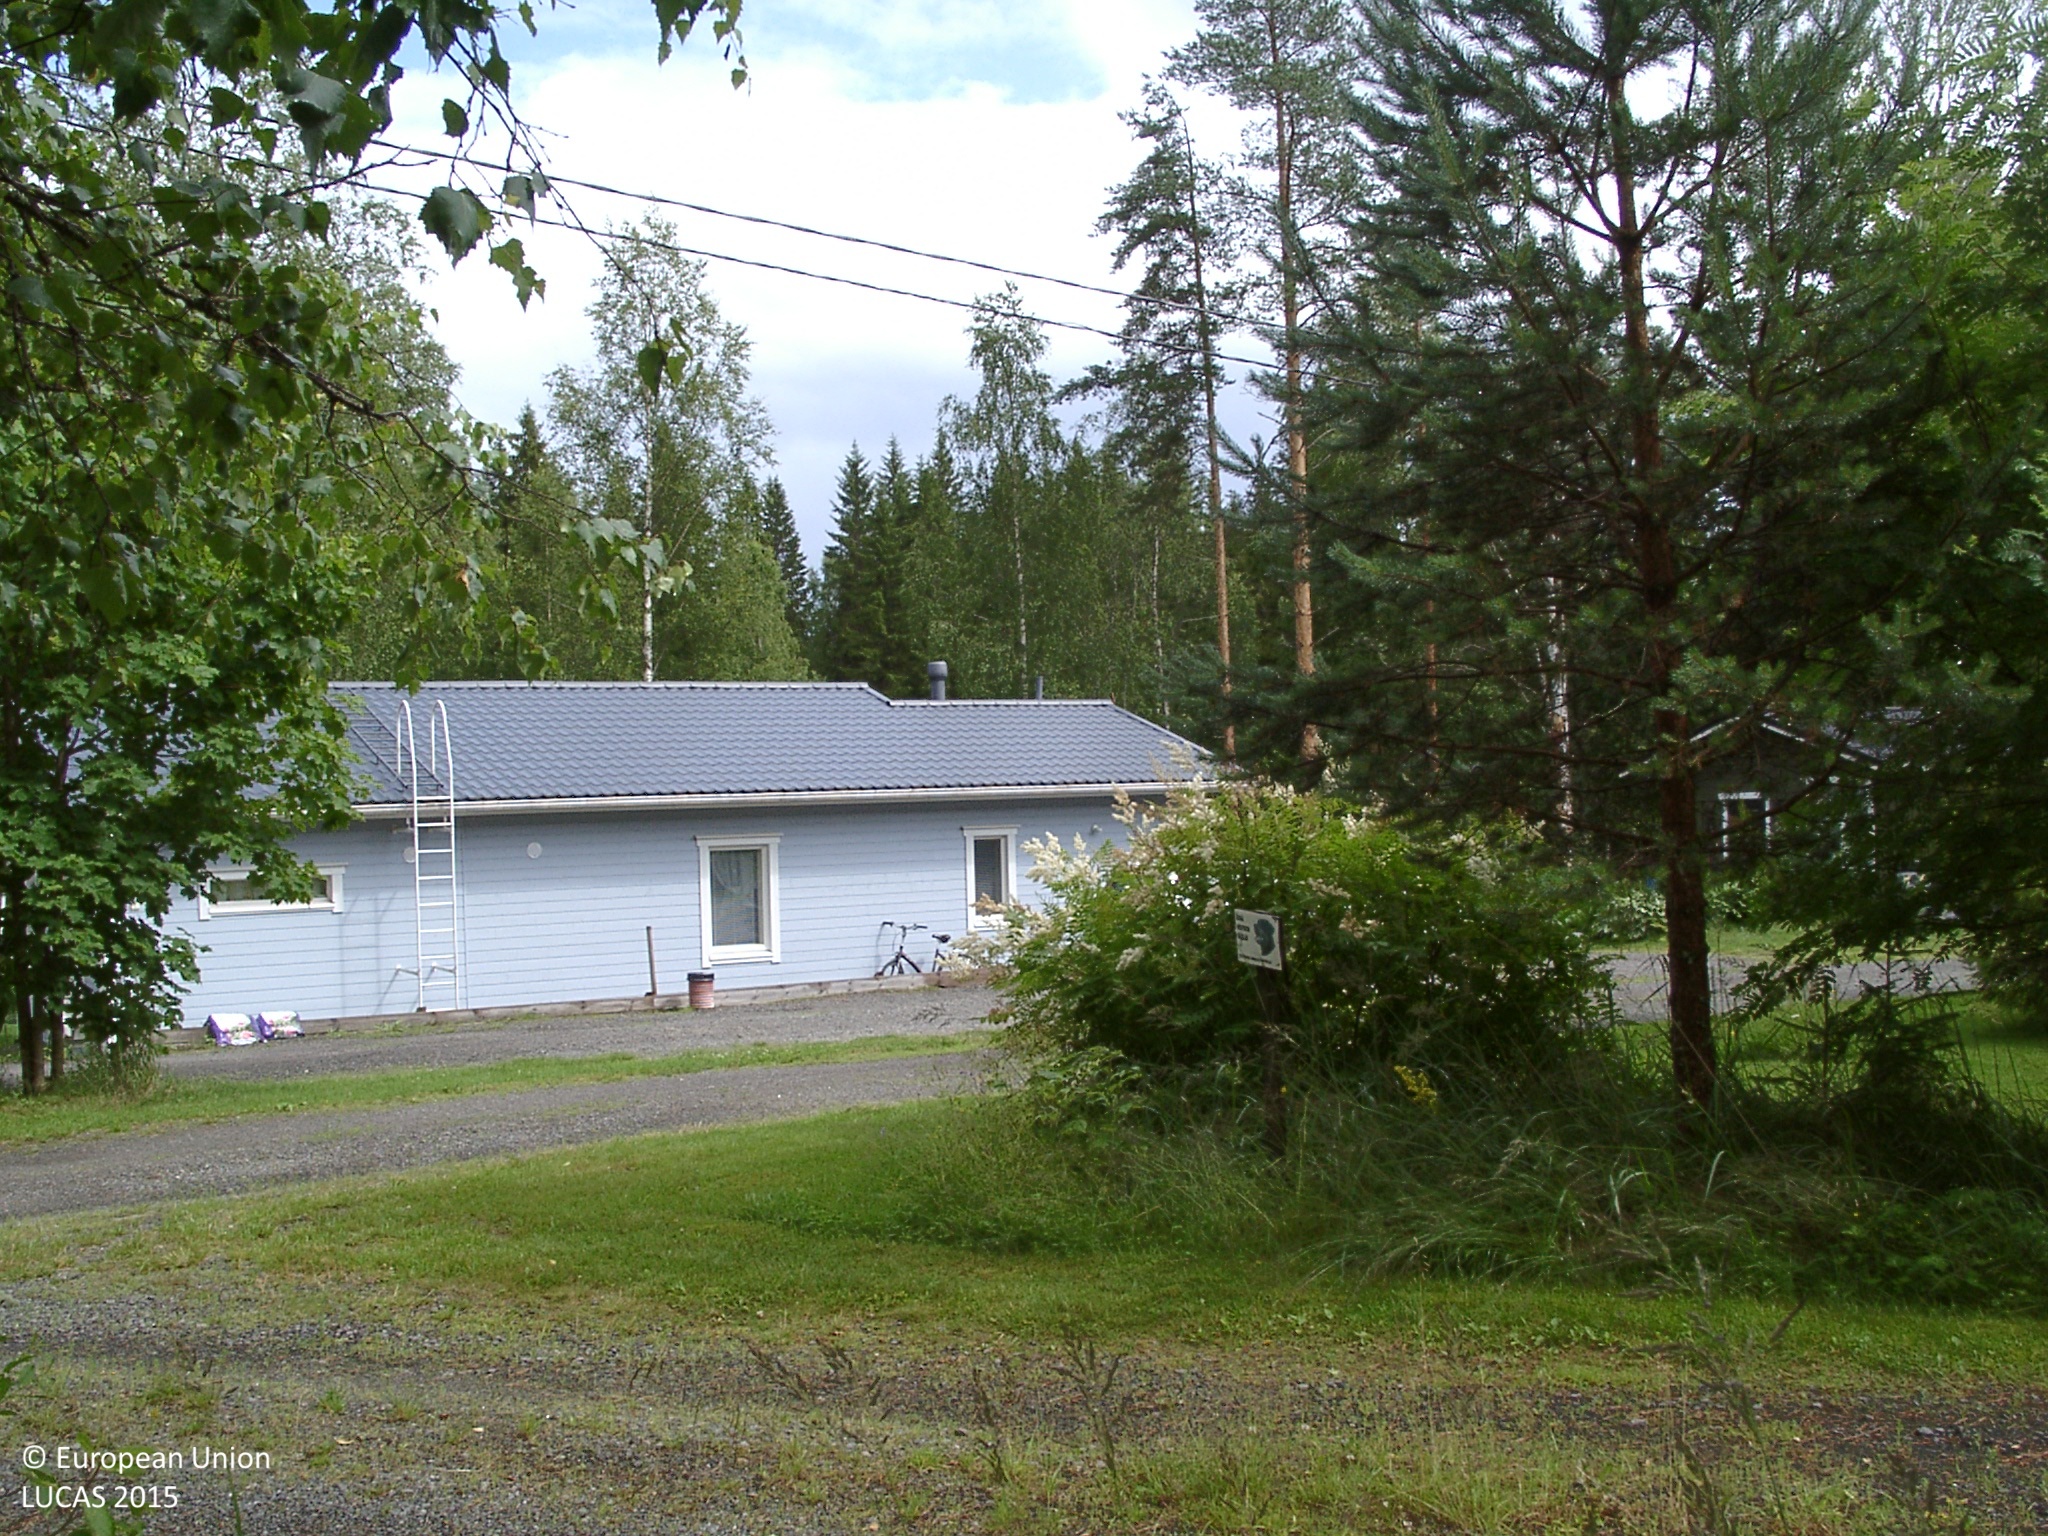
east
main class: Woodland
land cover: Broadleaved woodland
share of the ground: 25 - 50 %
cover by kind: broadleaved forest trees 35 %, herbaceous plants 30 %, coniferous forest trees 10 %, shrubs 10 %
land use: Residential
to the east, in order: Broadleaved woodland; Artificial constructions in urban areas; Broadleaved woodland; Rivers and streams; Spruce dominated mixed woodland; Tracks; Spruce dominated mixed woodland; Spruce dominated coniferous woodland; Grass margins; Paved roads, cycling and walking lanes; Other mixed woodland
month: July
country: FI
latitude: 62.2845
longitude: 25.1192
